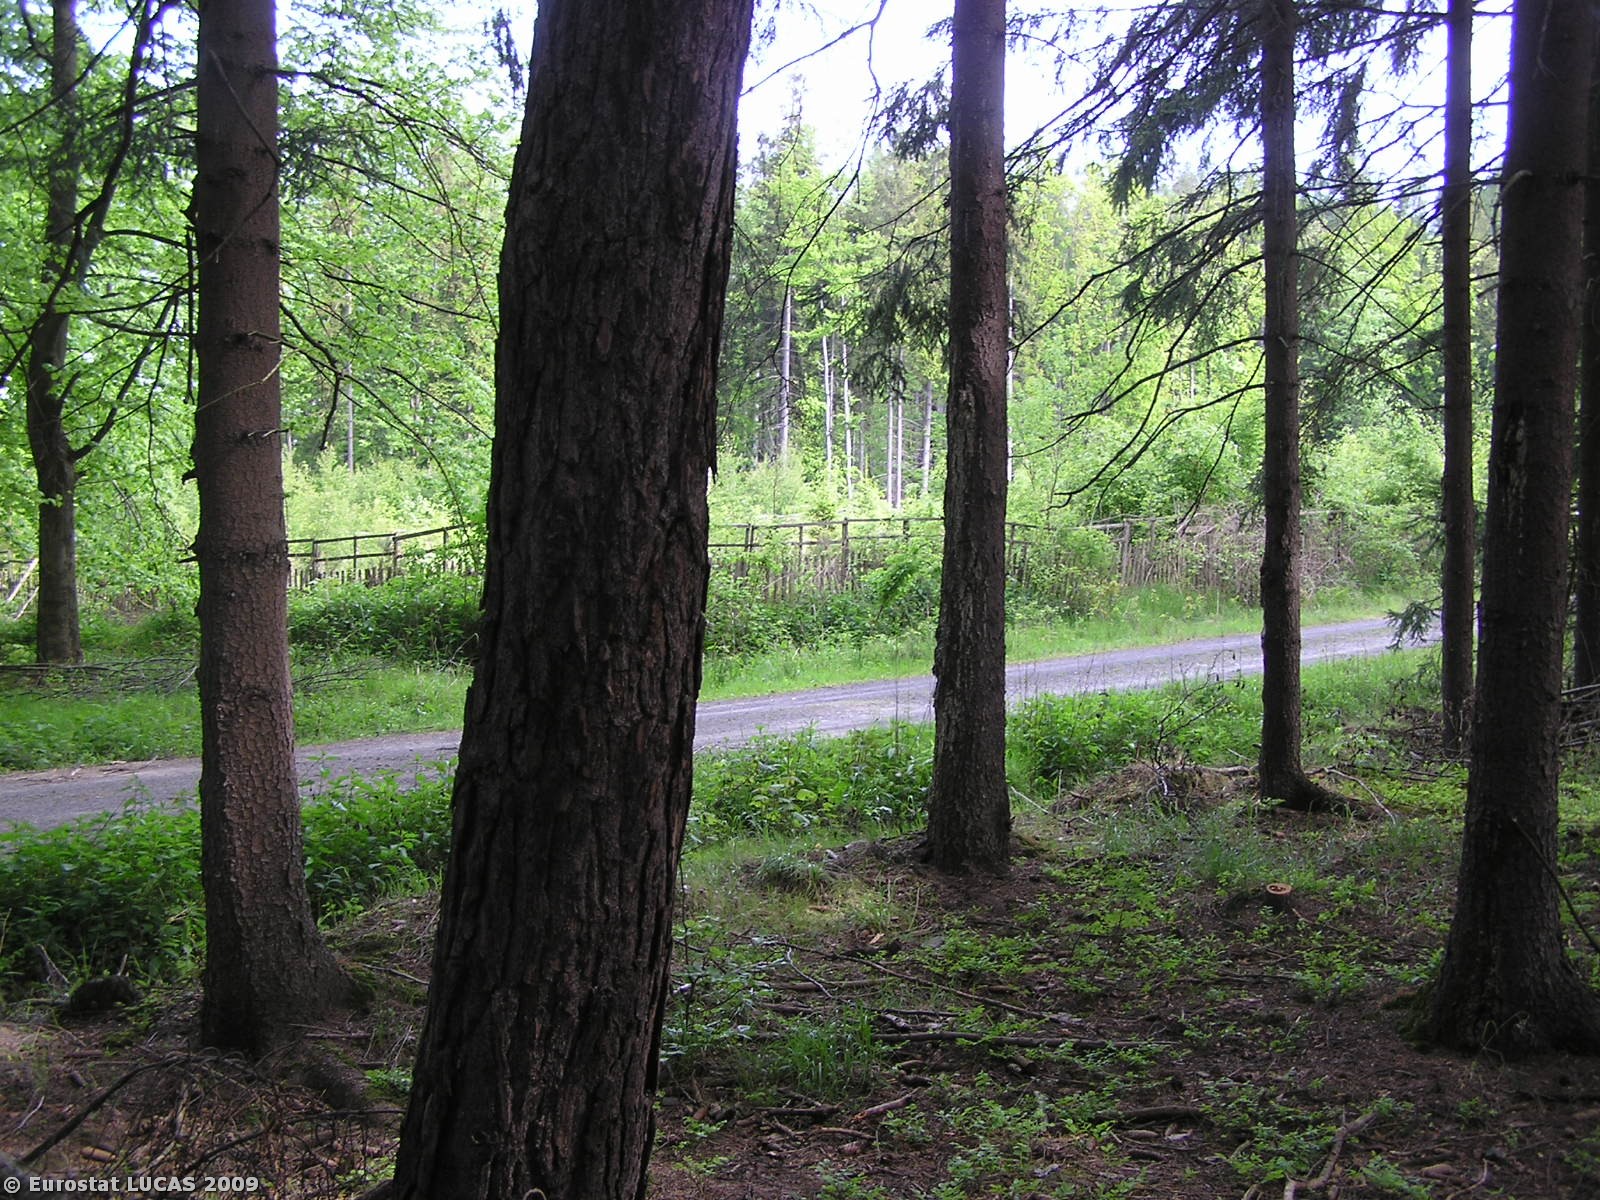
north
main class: Woodland
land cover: Coniferous woodland
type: hemiboreal forest and nemoral coniferous forest and mixed broadleaved-coniferous forest
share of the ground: > 75 %
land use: Forestry
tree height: > 5 m
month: May
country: CZ
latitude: 49.8943
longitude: 17.5996
